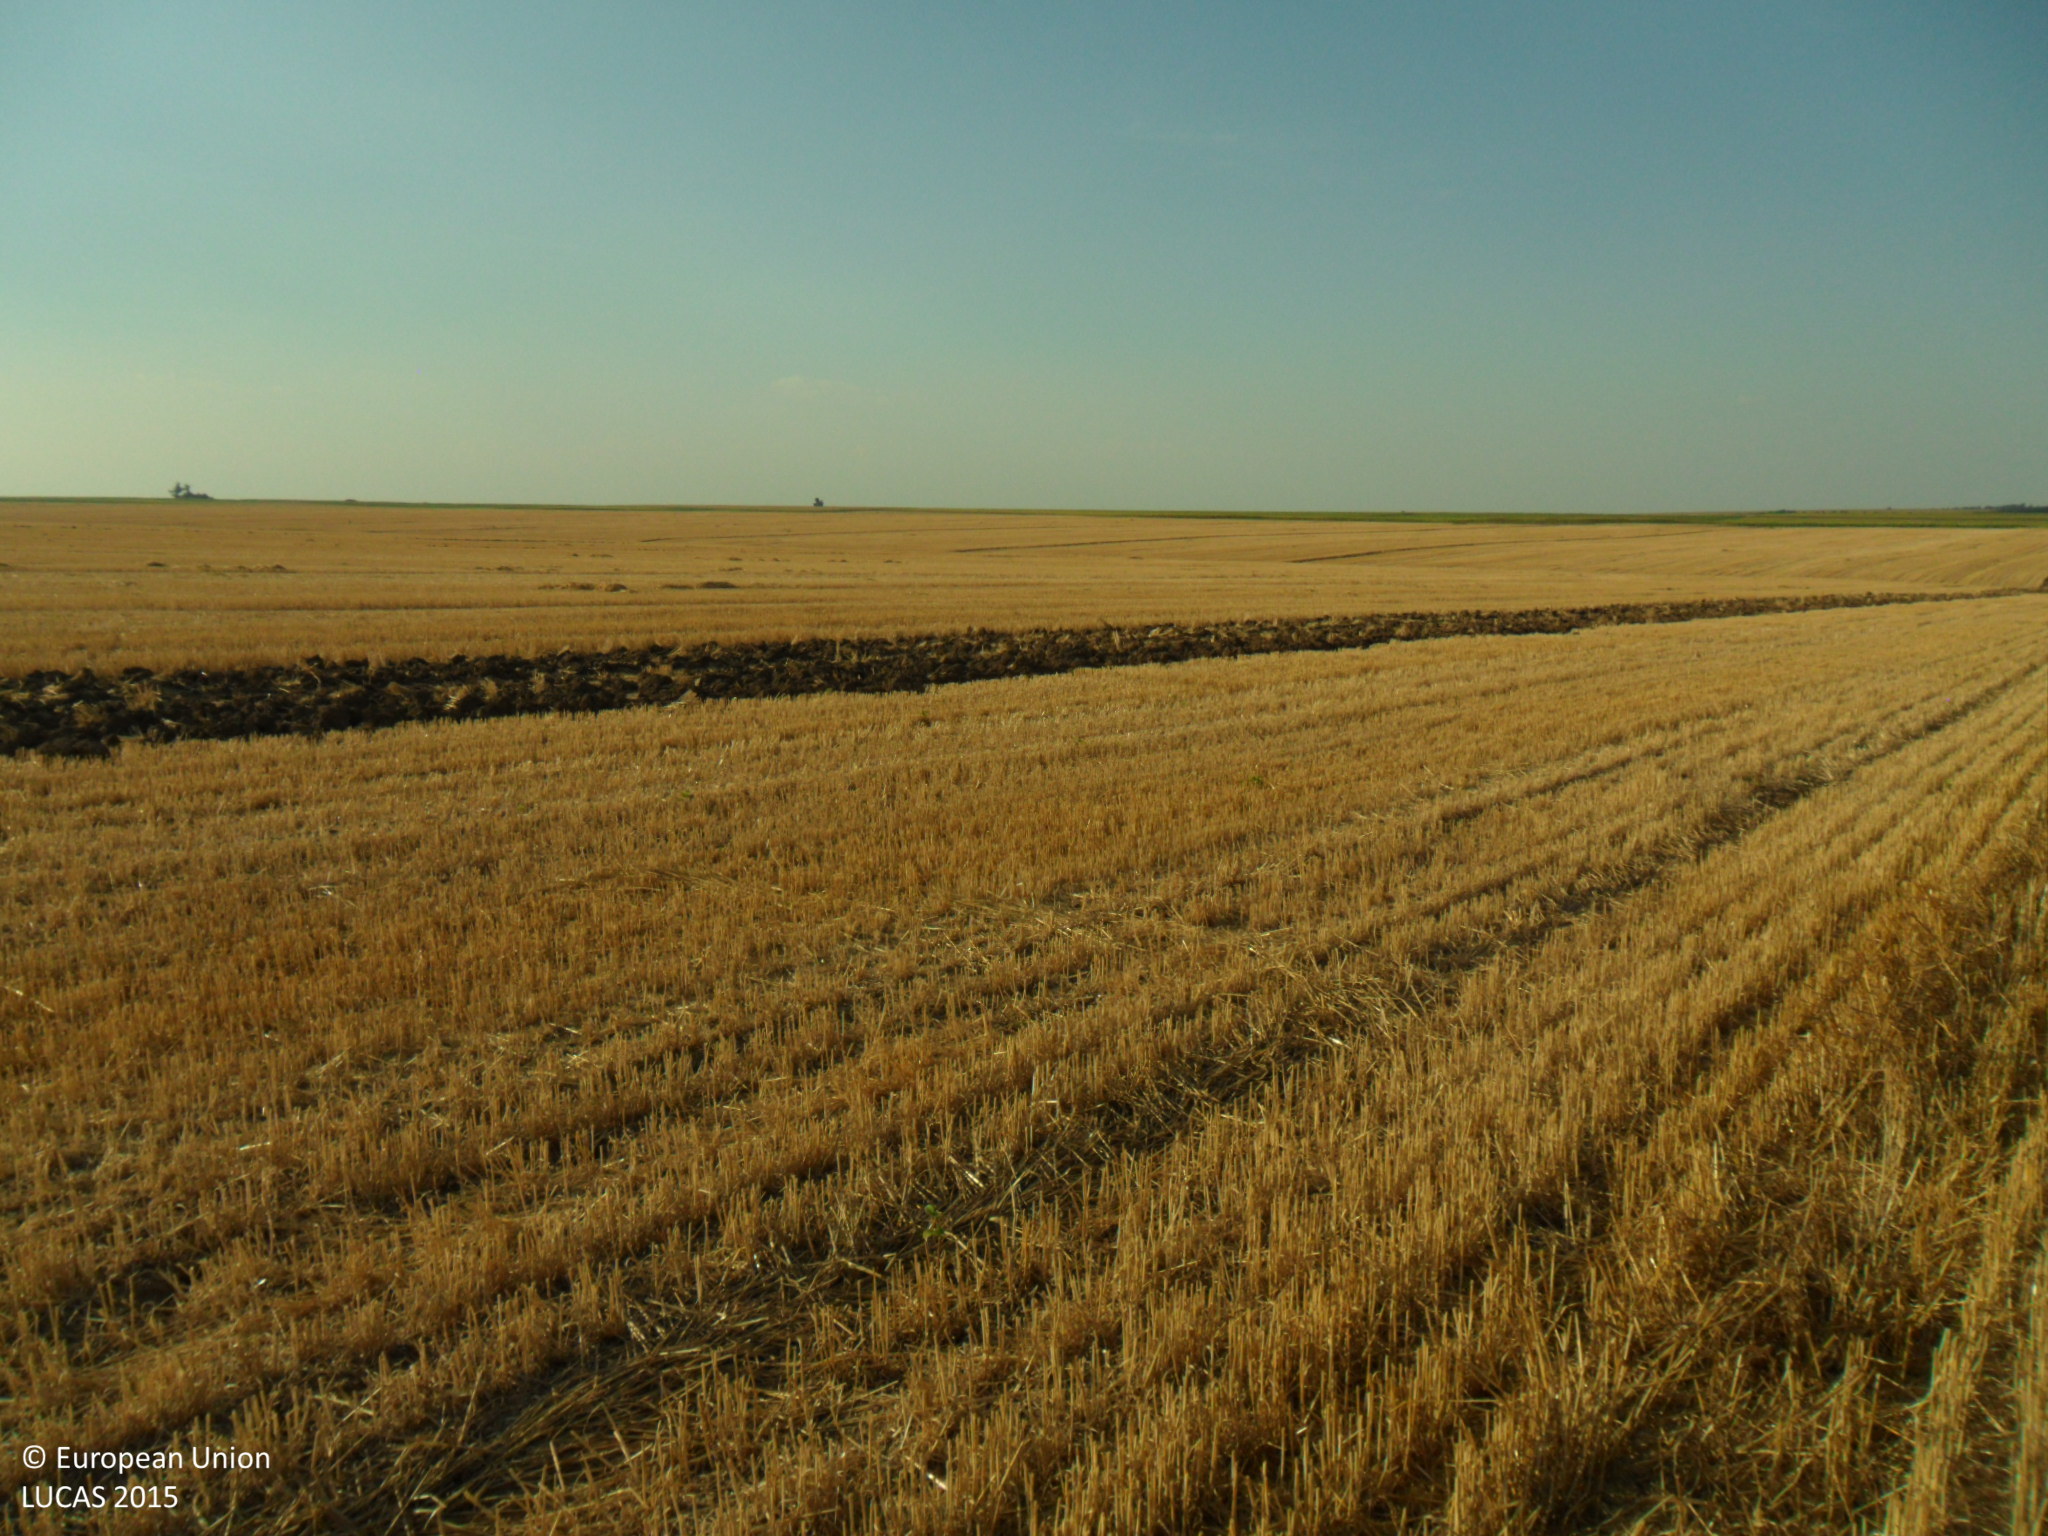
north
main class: Cropland
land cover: Common wheat
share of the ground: 25 - 50 %
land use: Agriculture (excluding fallow land and kitchen gardens)
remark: Harvested field
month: August
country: BG
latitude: 43.6510
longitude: 27.1207
